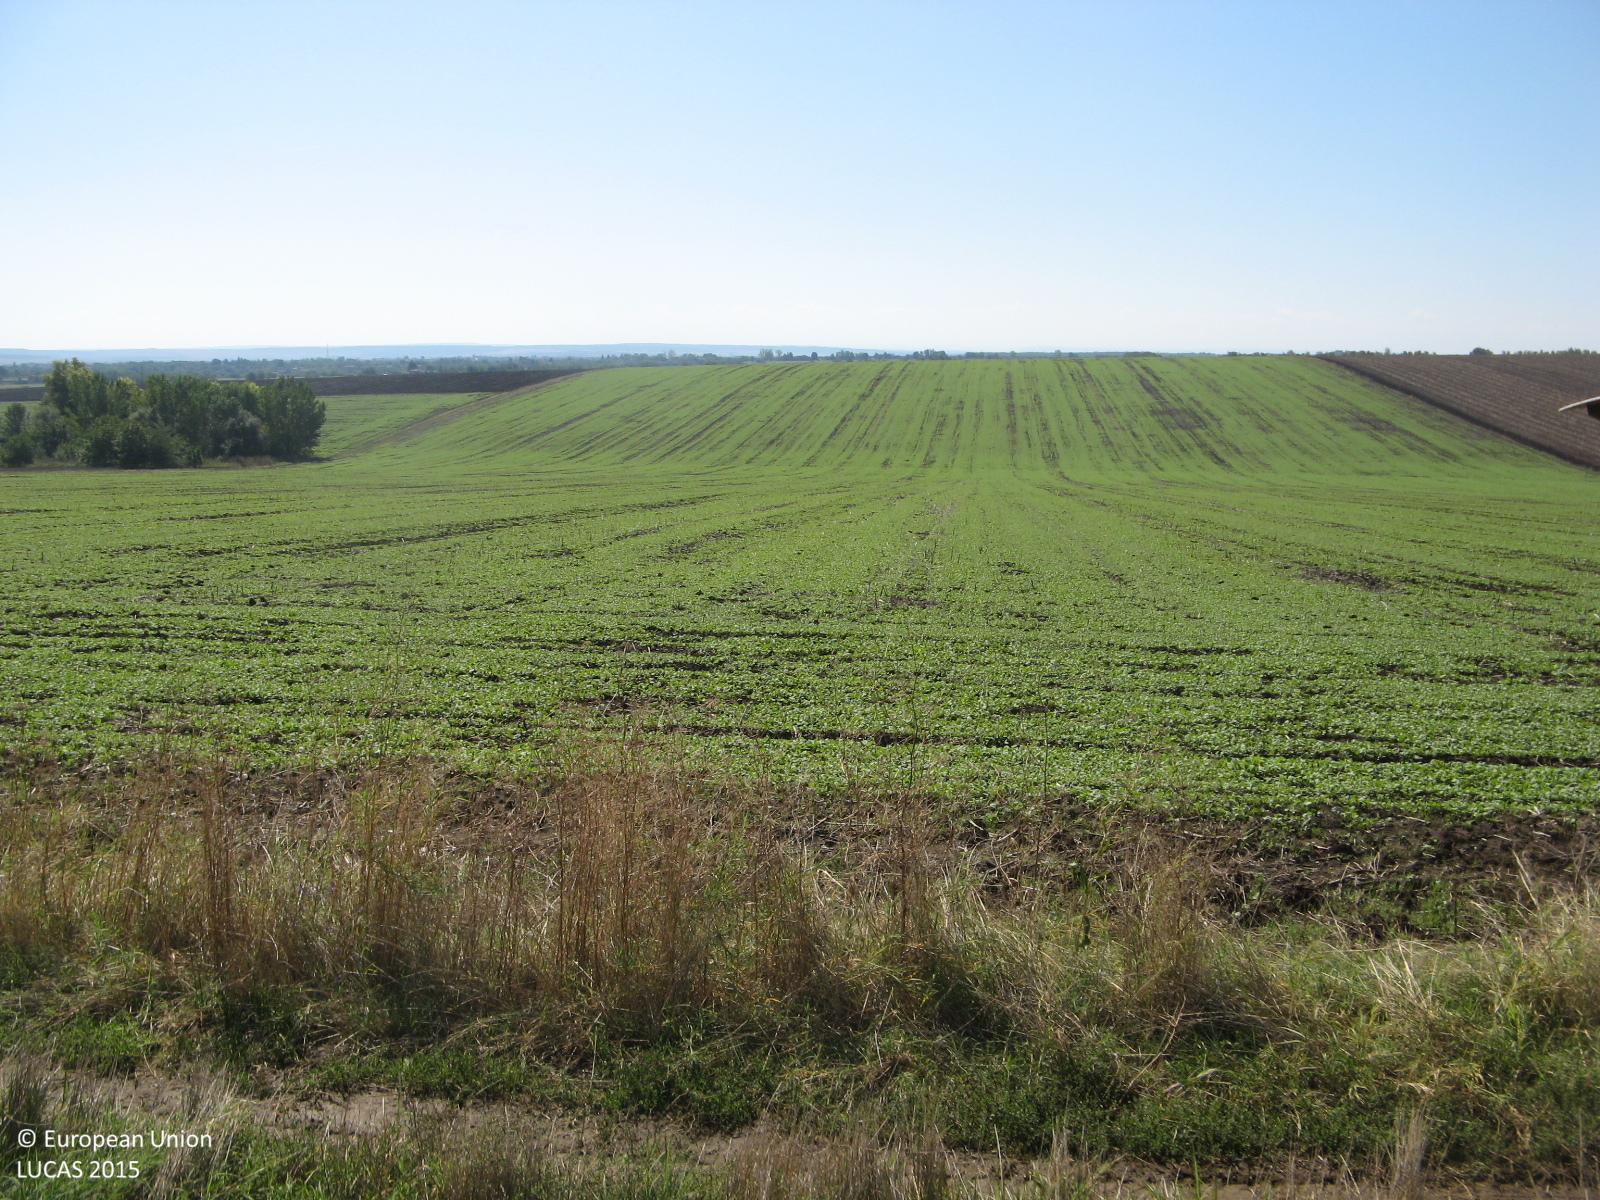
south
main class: Cropland
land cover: Common wheat
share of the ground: < 10 %
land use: Agriculture (excluding fallow land and kitchen gardens)
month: September
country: BG
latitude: 43.4408
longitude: 25.3364
